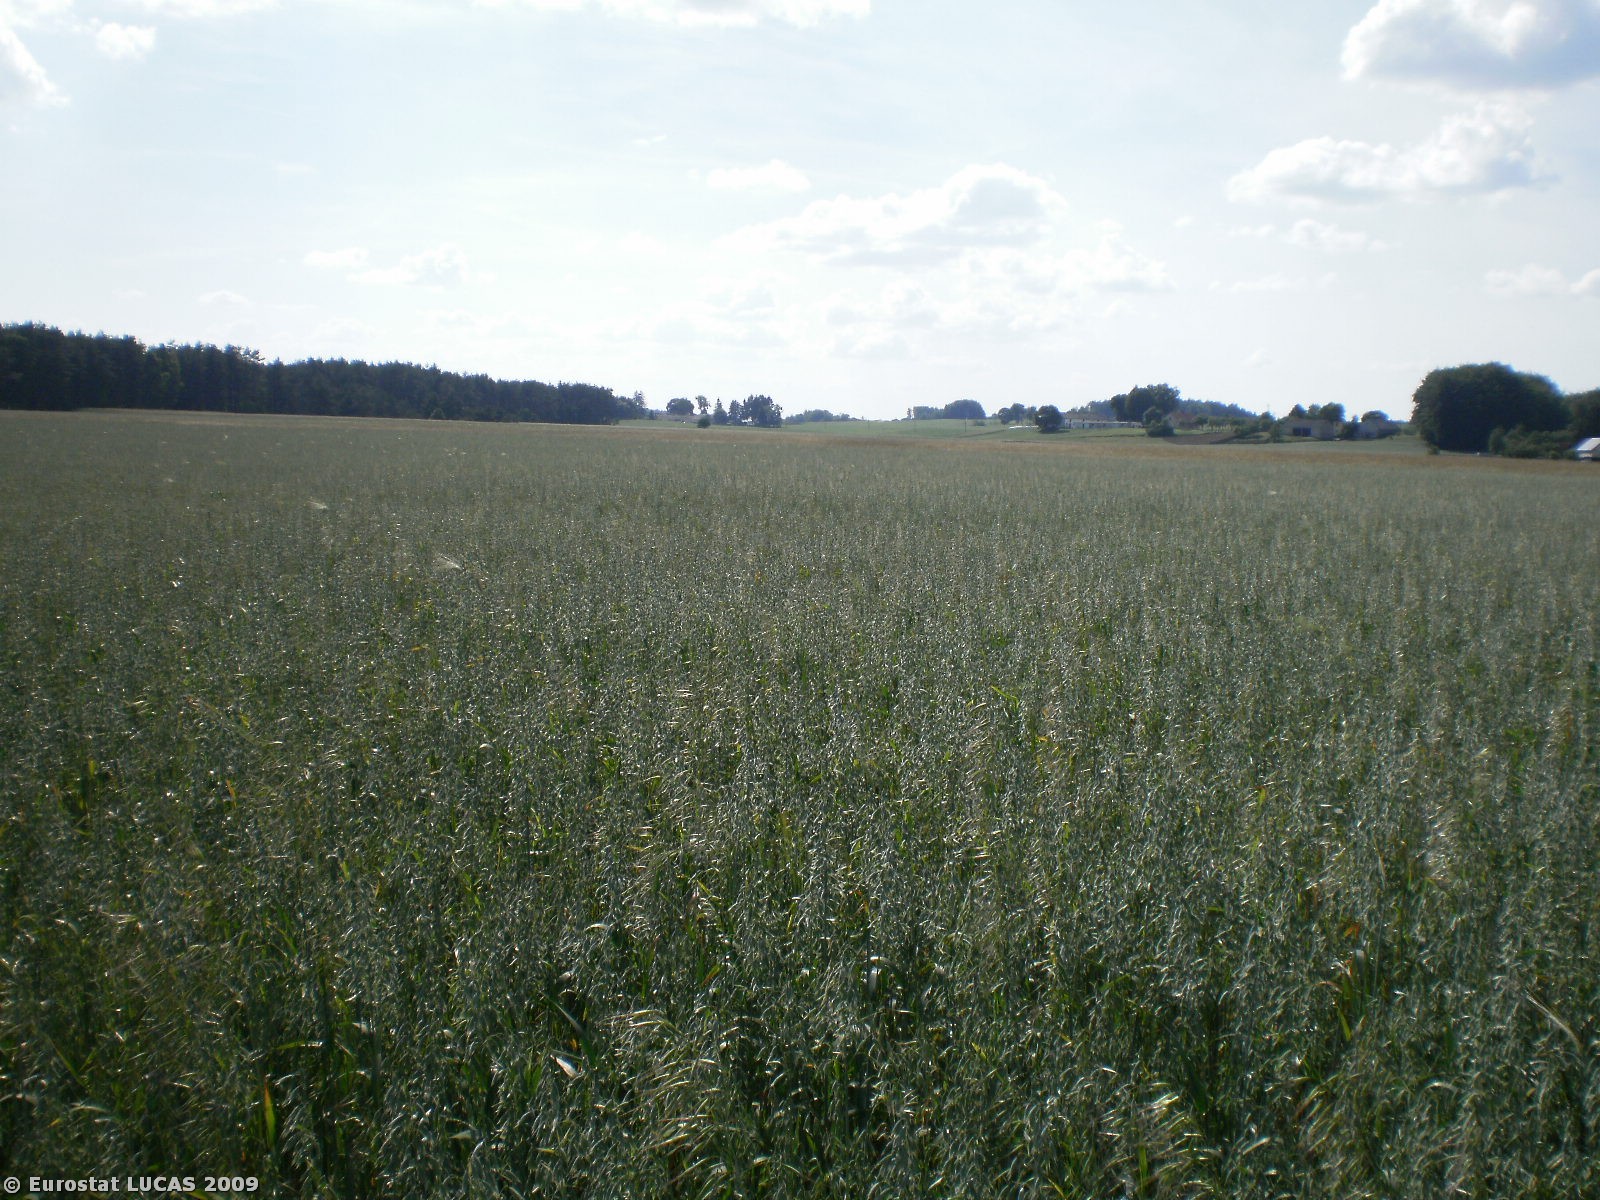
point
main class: Cropland
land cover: Oats
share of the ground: > 75 %
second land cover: Rye
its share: < 10 %
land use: Agriculture (excluding fallow land and kitchen gardens)
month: July
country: PL
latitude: 54.2089
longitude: 17.9096
